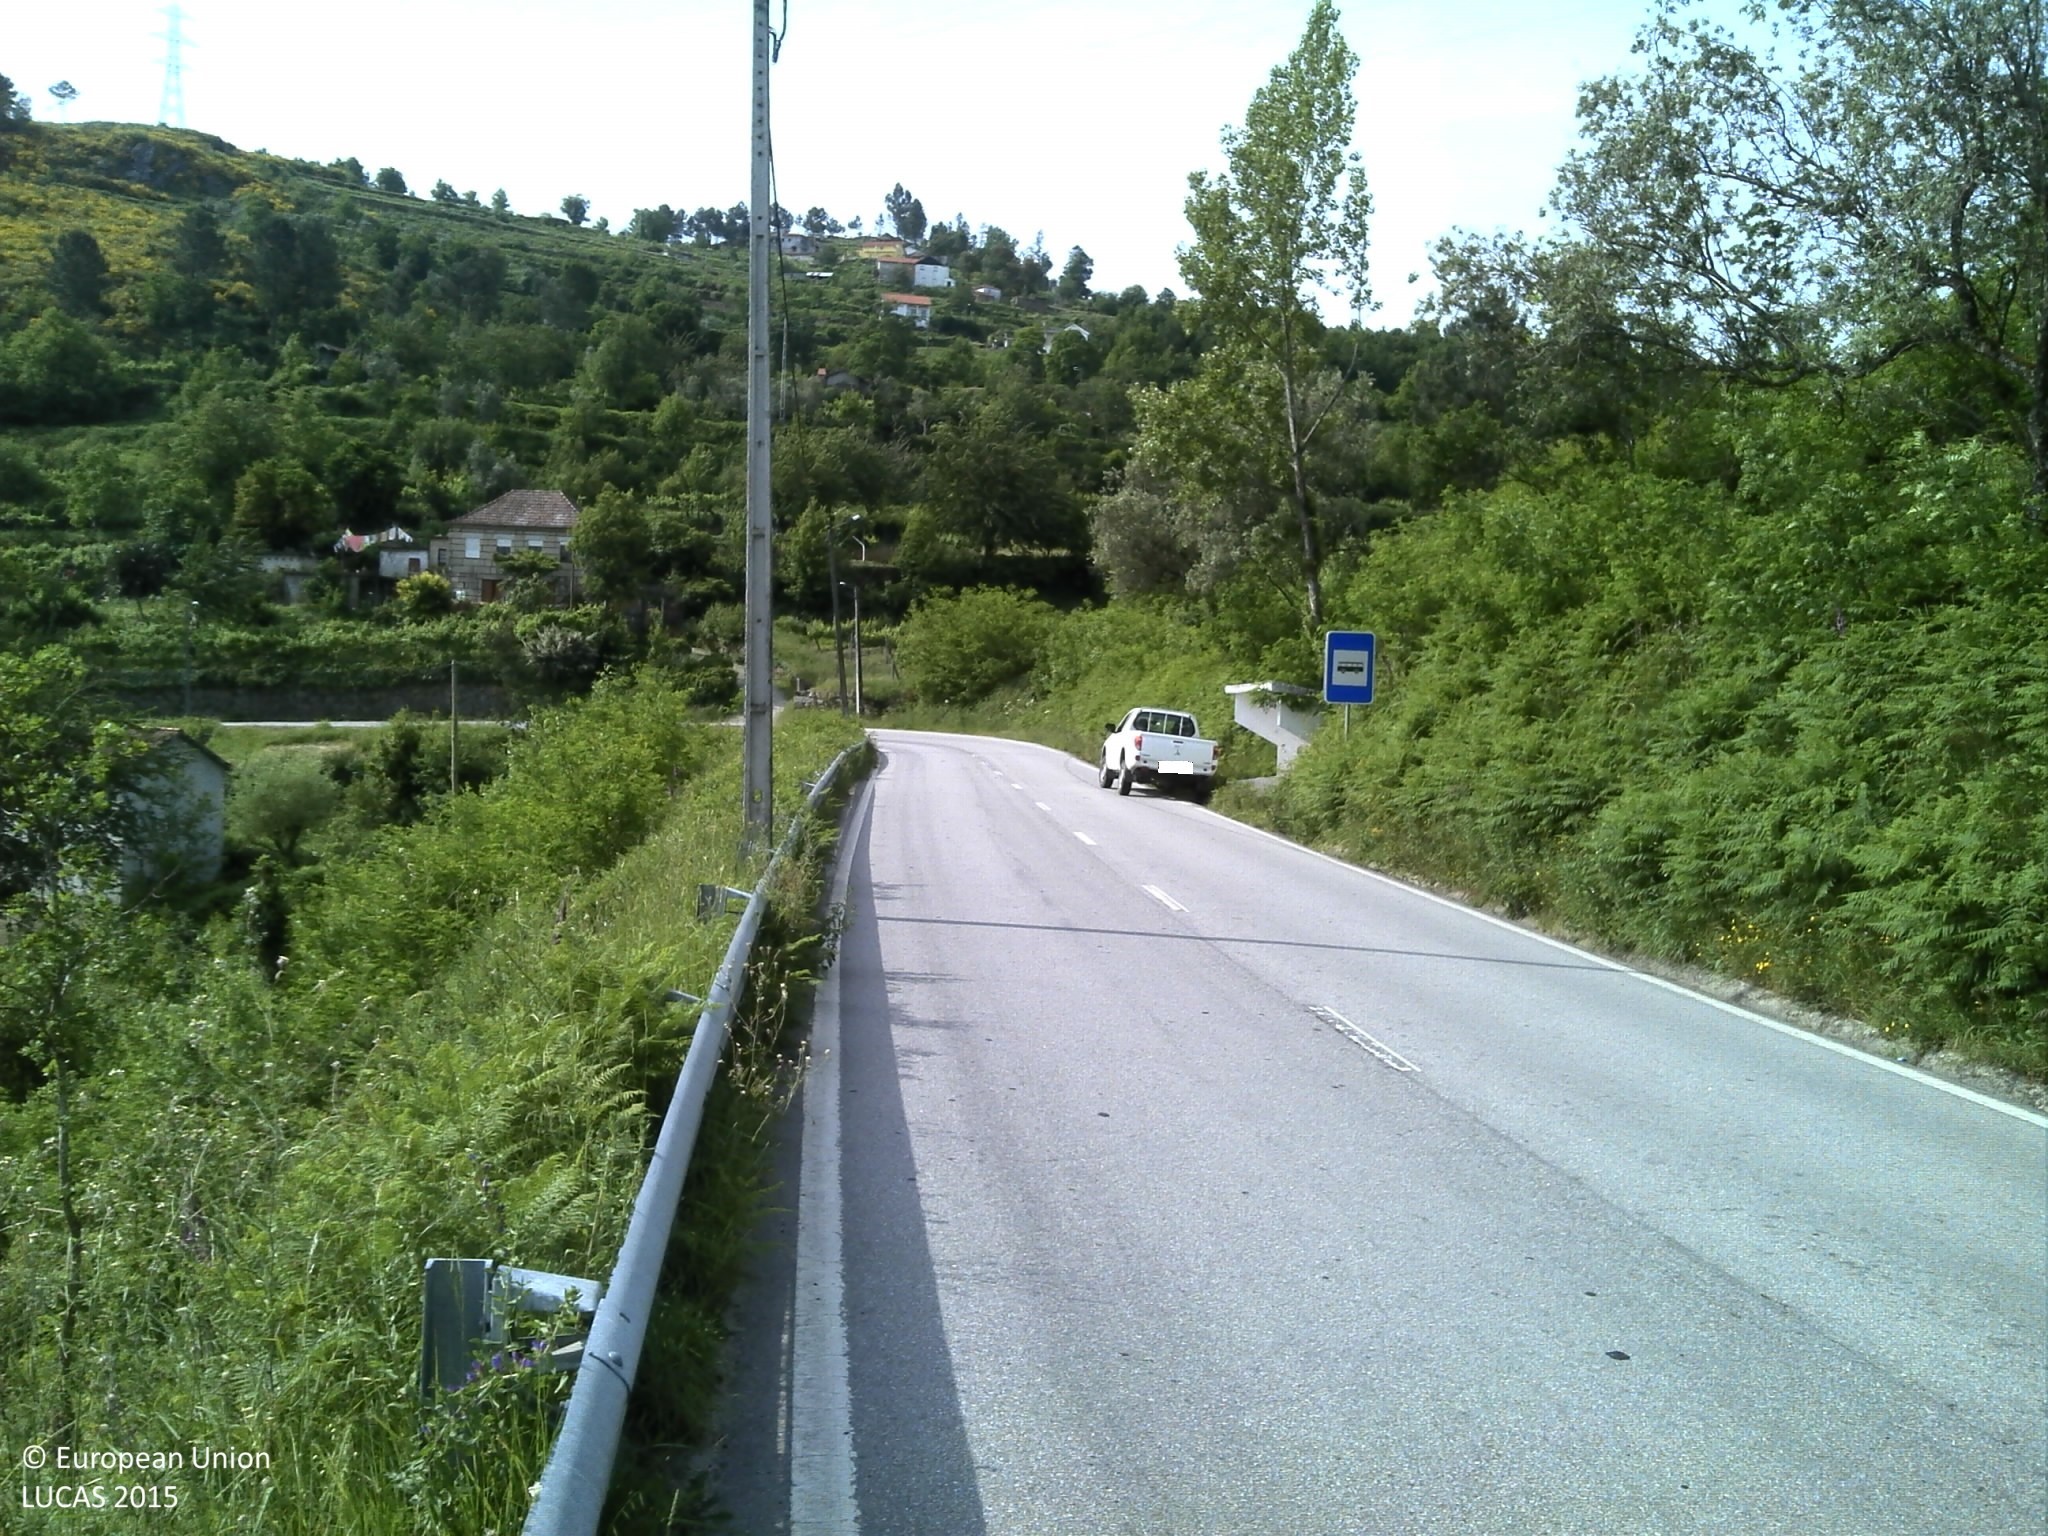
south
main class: Woodland
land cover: Broadleaved woodland
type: thermophilous deciduous forest
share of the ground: > 75 %
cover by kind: broadleaved forest trees 85 %, shrubs 5 %, herbaceous plants 5 %, unconsolidated bare surface 5 %
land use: Forestry
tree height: > 5 m
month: May
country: PT
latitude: 41.0770
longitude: -8.1217
